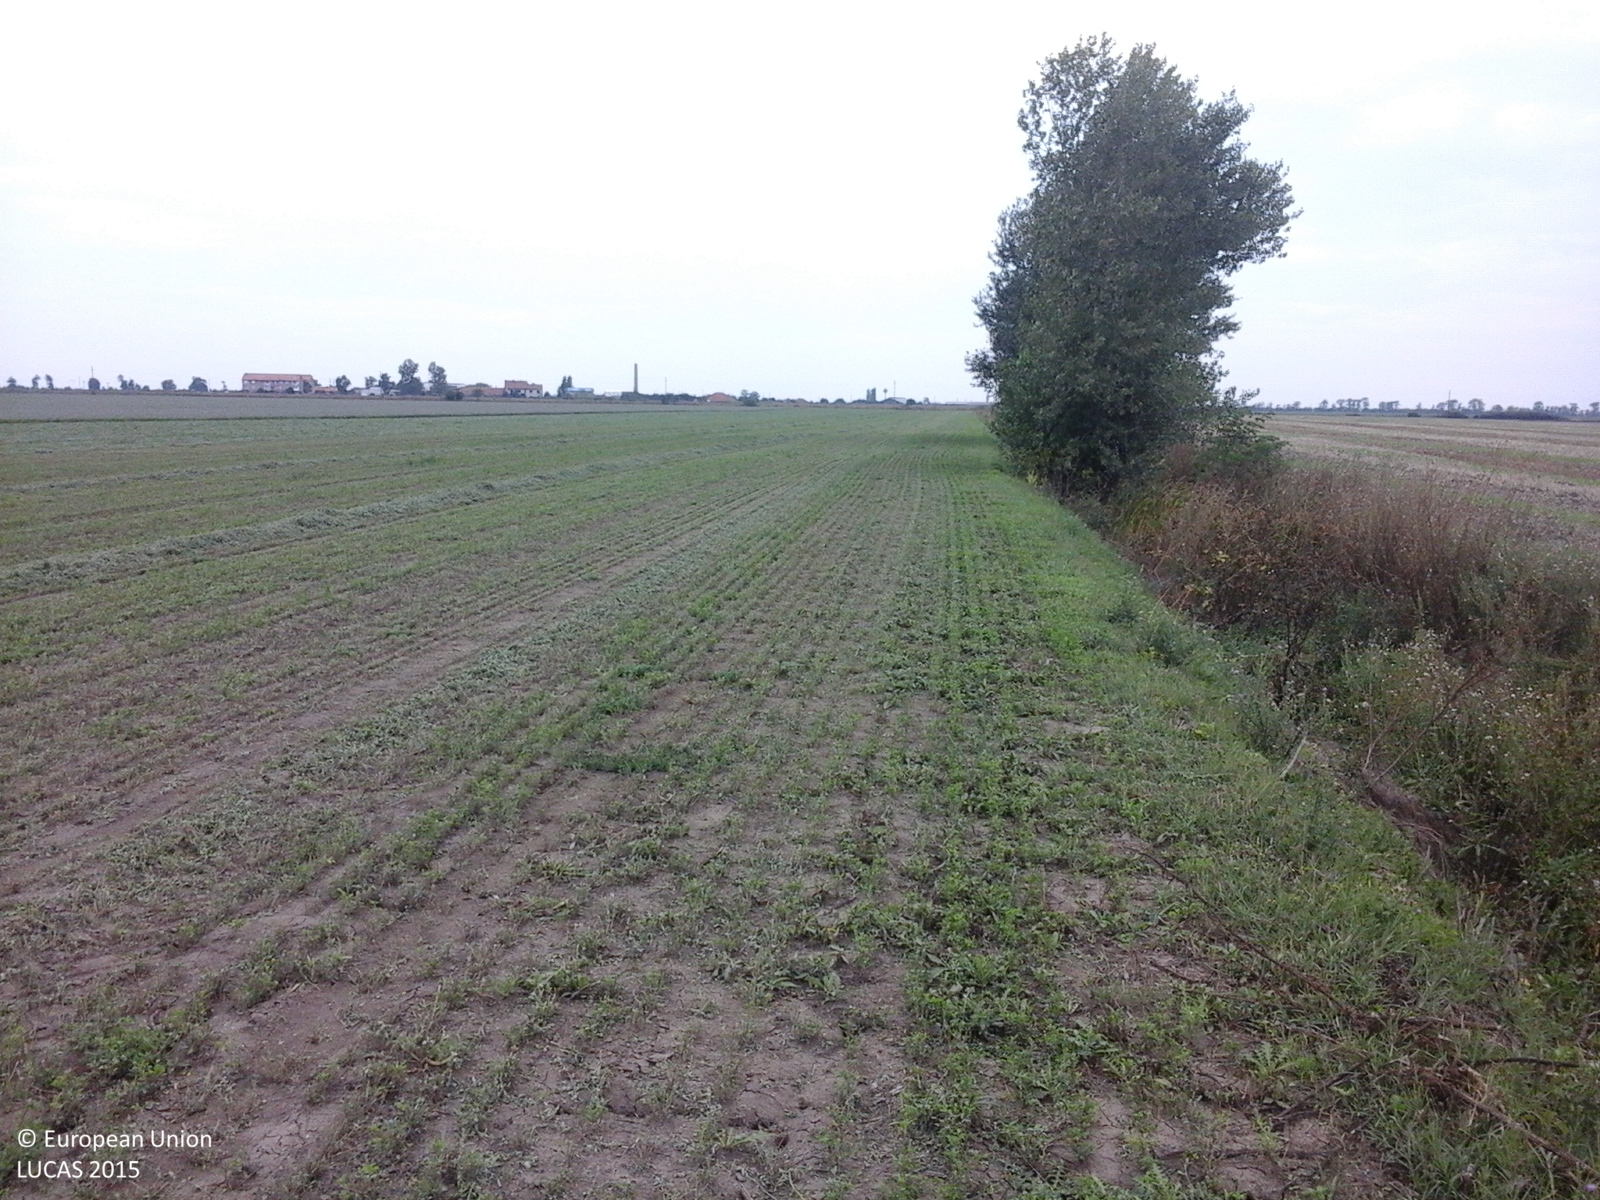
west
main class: Cropland
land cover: Lucerne
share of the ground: 50 - 75 %
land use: Agriculture (excluding fallow land and kitchen gardens)
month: August
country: RO
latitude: 46.2667
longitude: 21.2307
